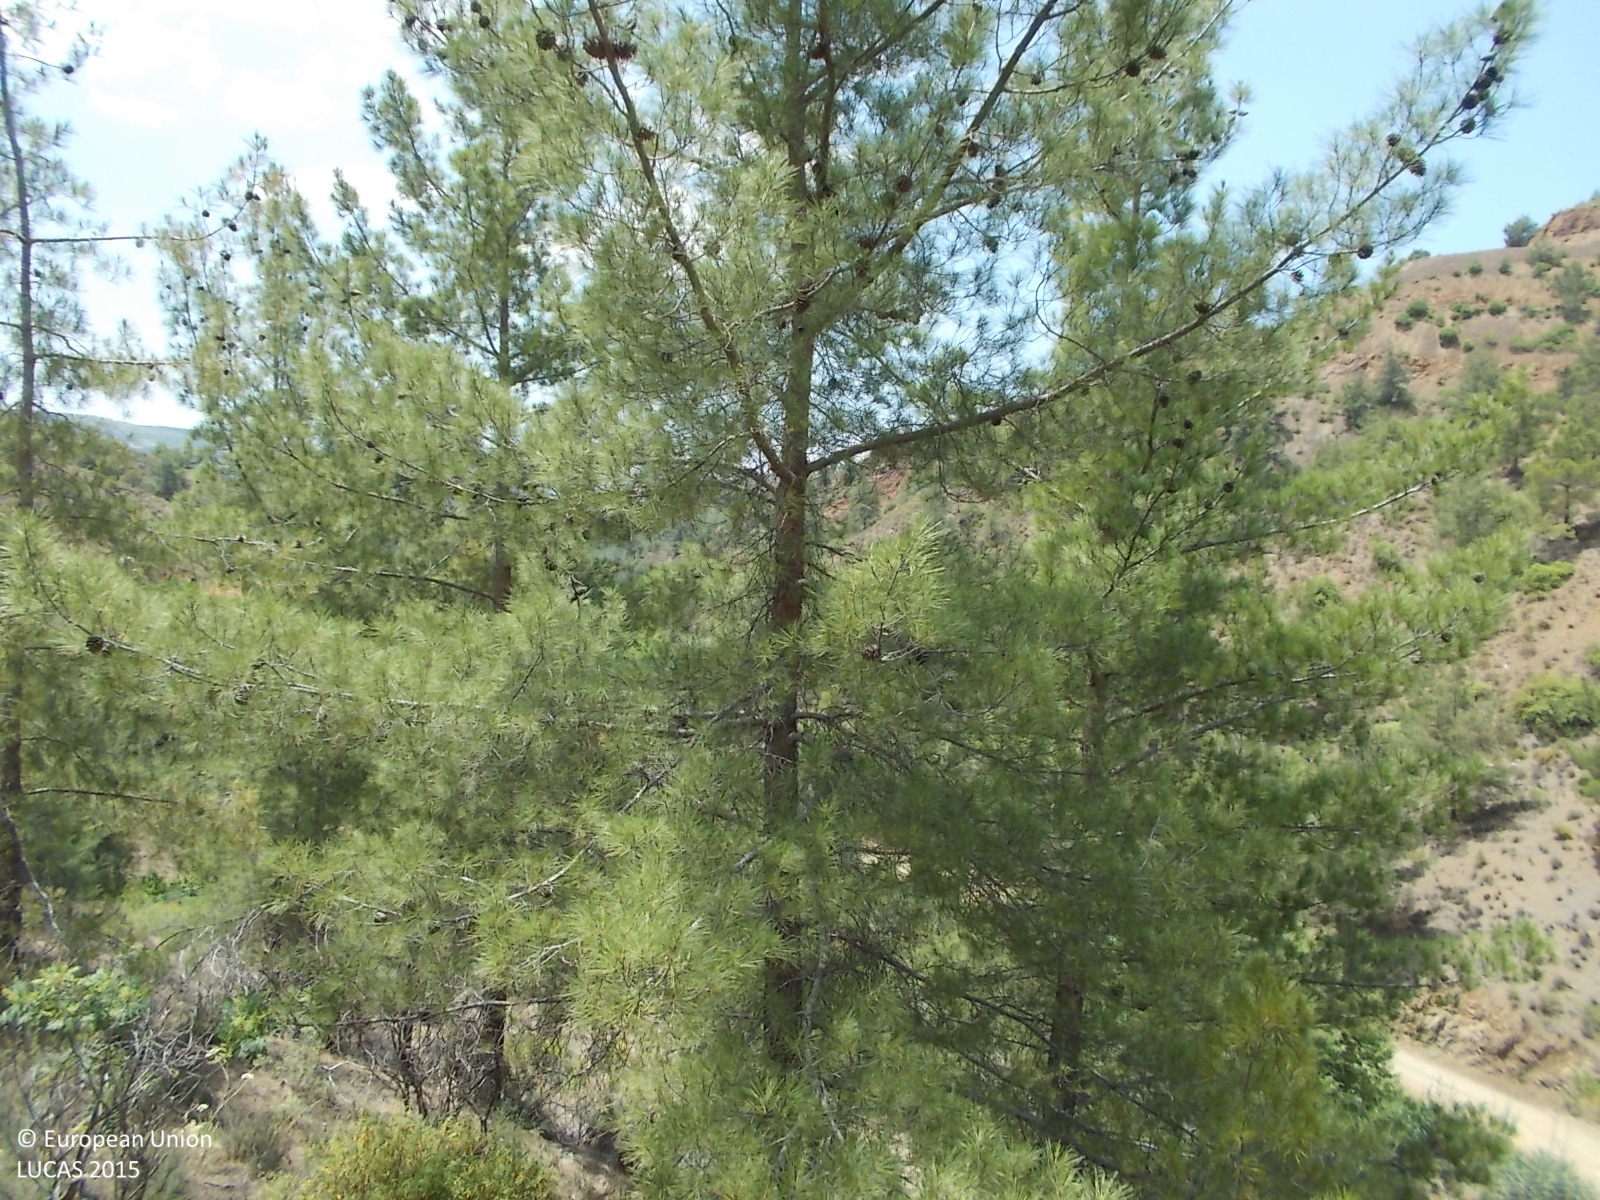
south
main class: Woodland
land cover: Pine dominated coniferous woodland
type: coniferous forest of the mediterranean region
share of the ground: 25 - 50 %
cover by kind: coniferous forest trees 40 %, unconsolidated bare surface 40 %, shrubs 20 %
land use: Forestry
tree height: > 5 m
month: June
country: CY
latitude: 34.8772
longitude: 32.8205
